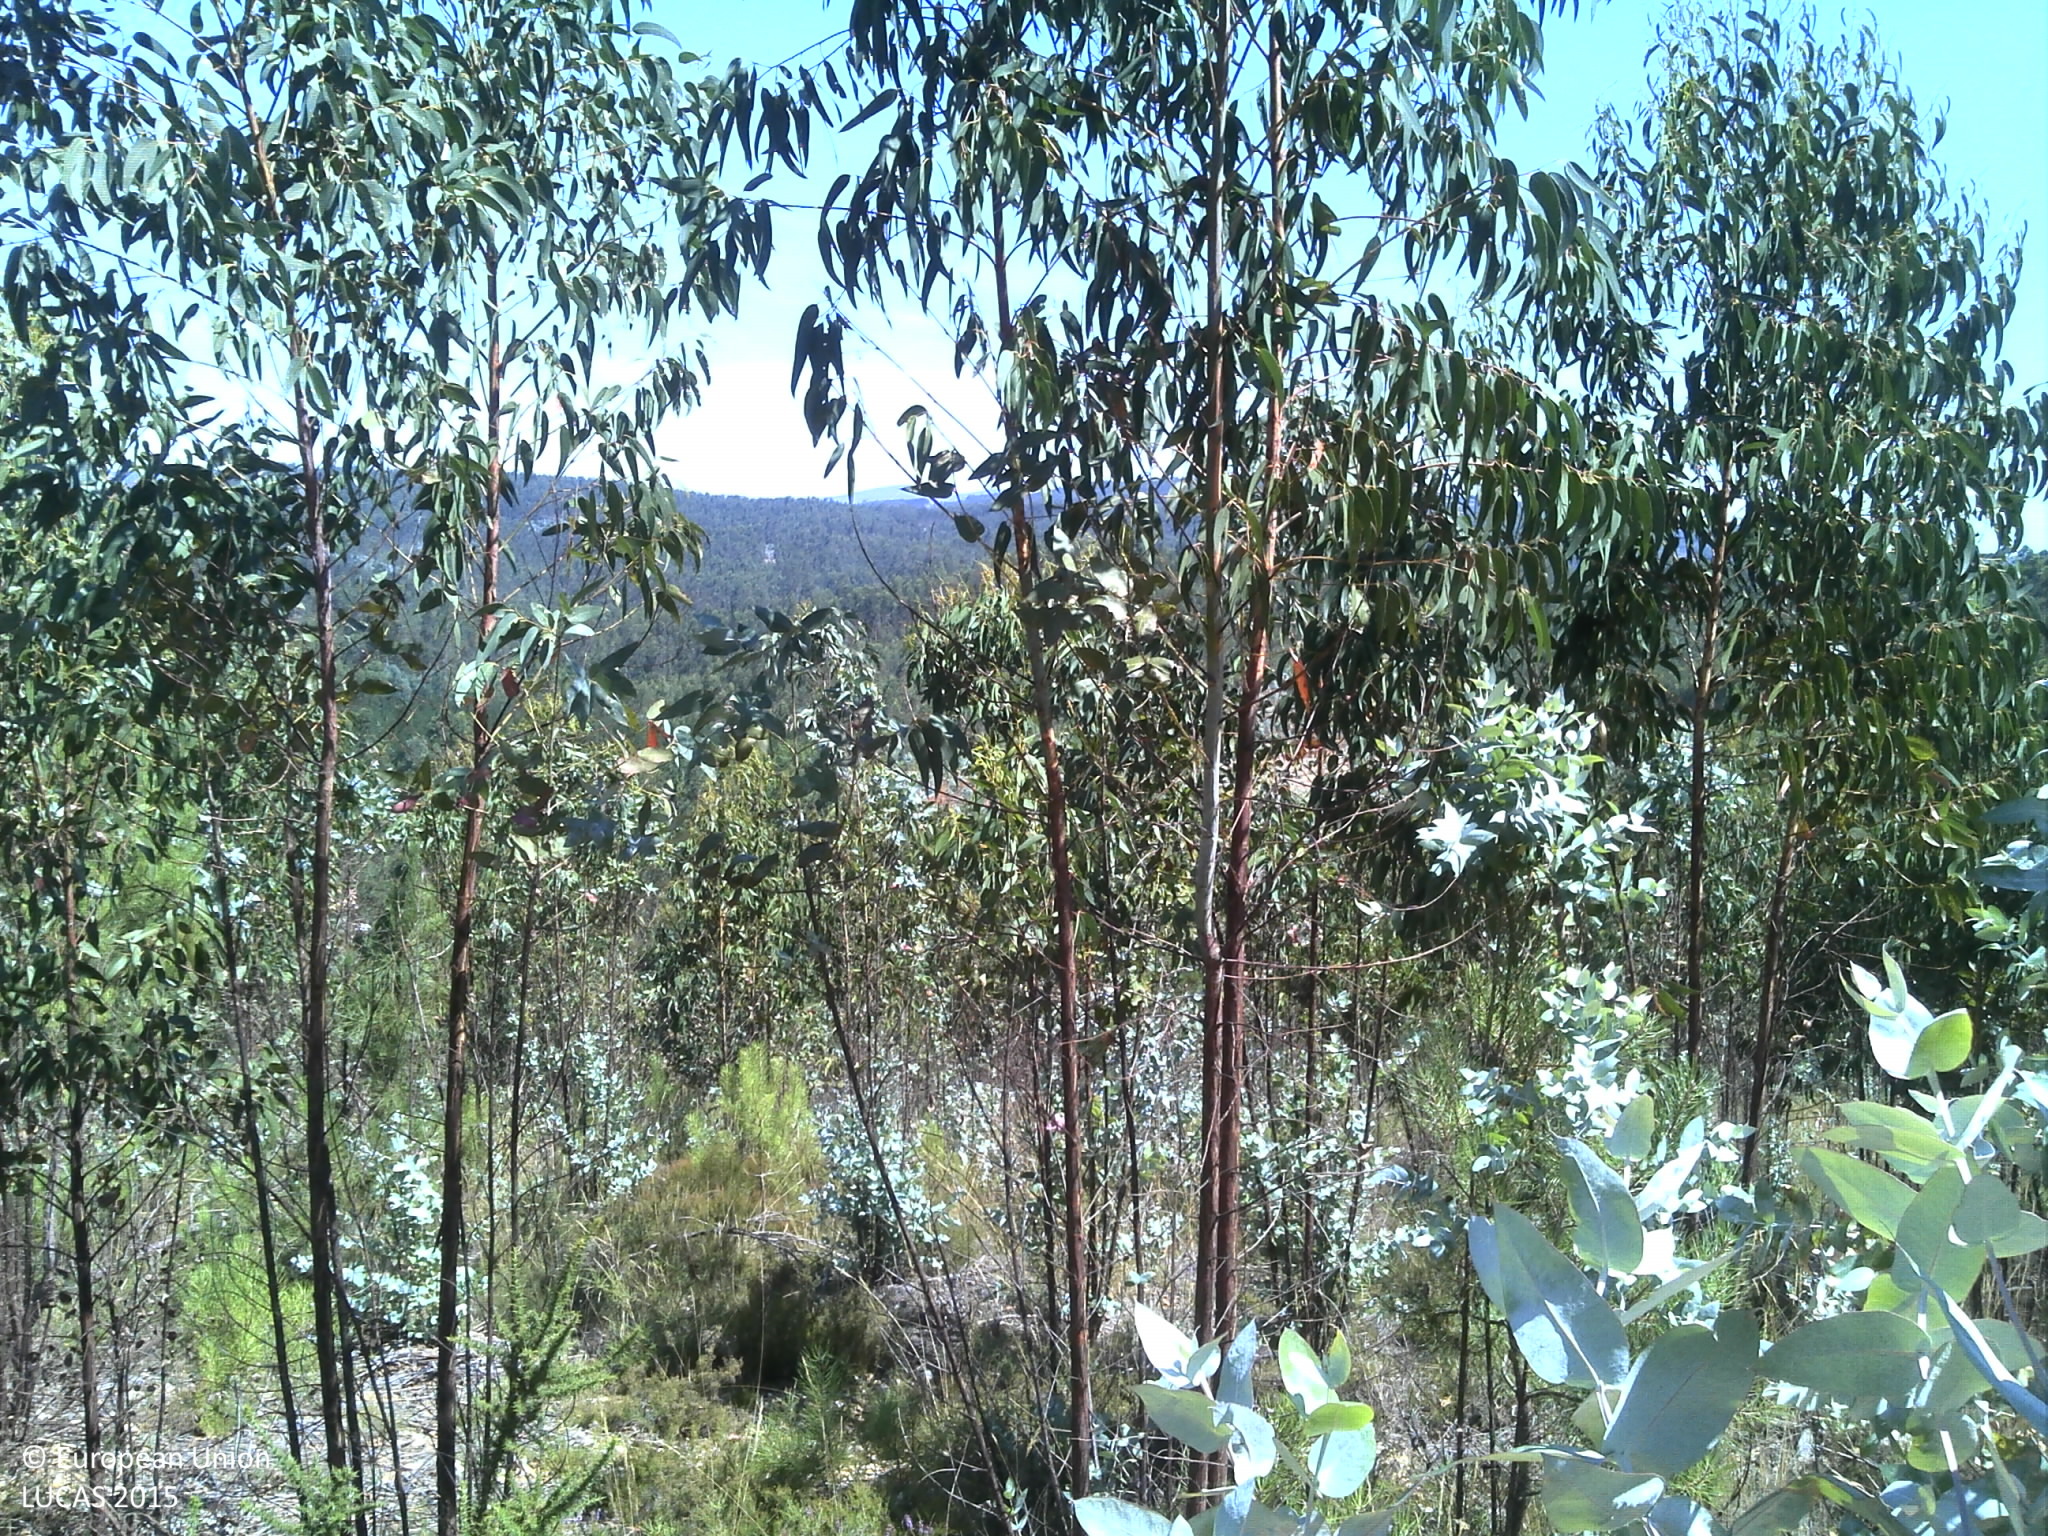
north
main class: Woodland
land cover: Broadleaved woodland
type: exotic forest
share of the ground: 10 - 25 %
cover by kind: unconsolidated bare surface 70 %, broadleaved forest trees 25 %, shrubs 5 %
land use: Forestry
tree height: < 5 m
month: July
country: PT
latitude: 40.4257
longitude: -8.2457
